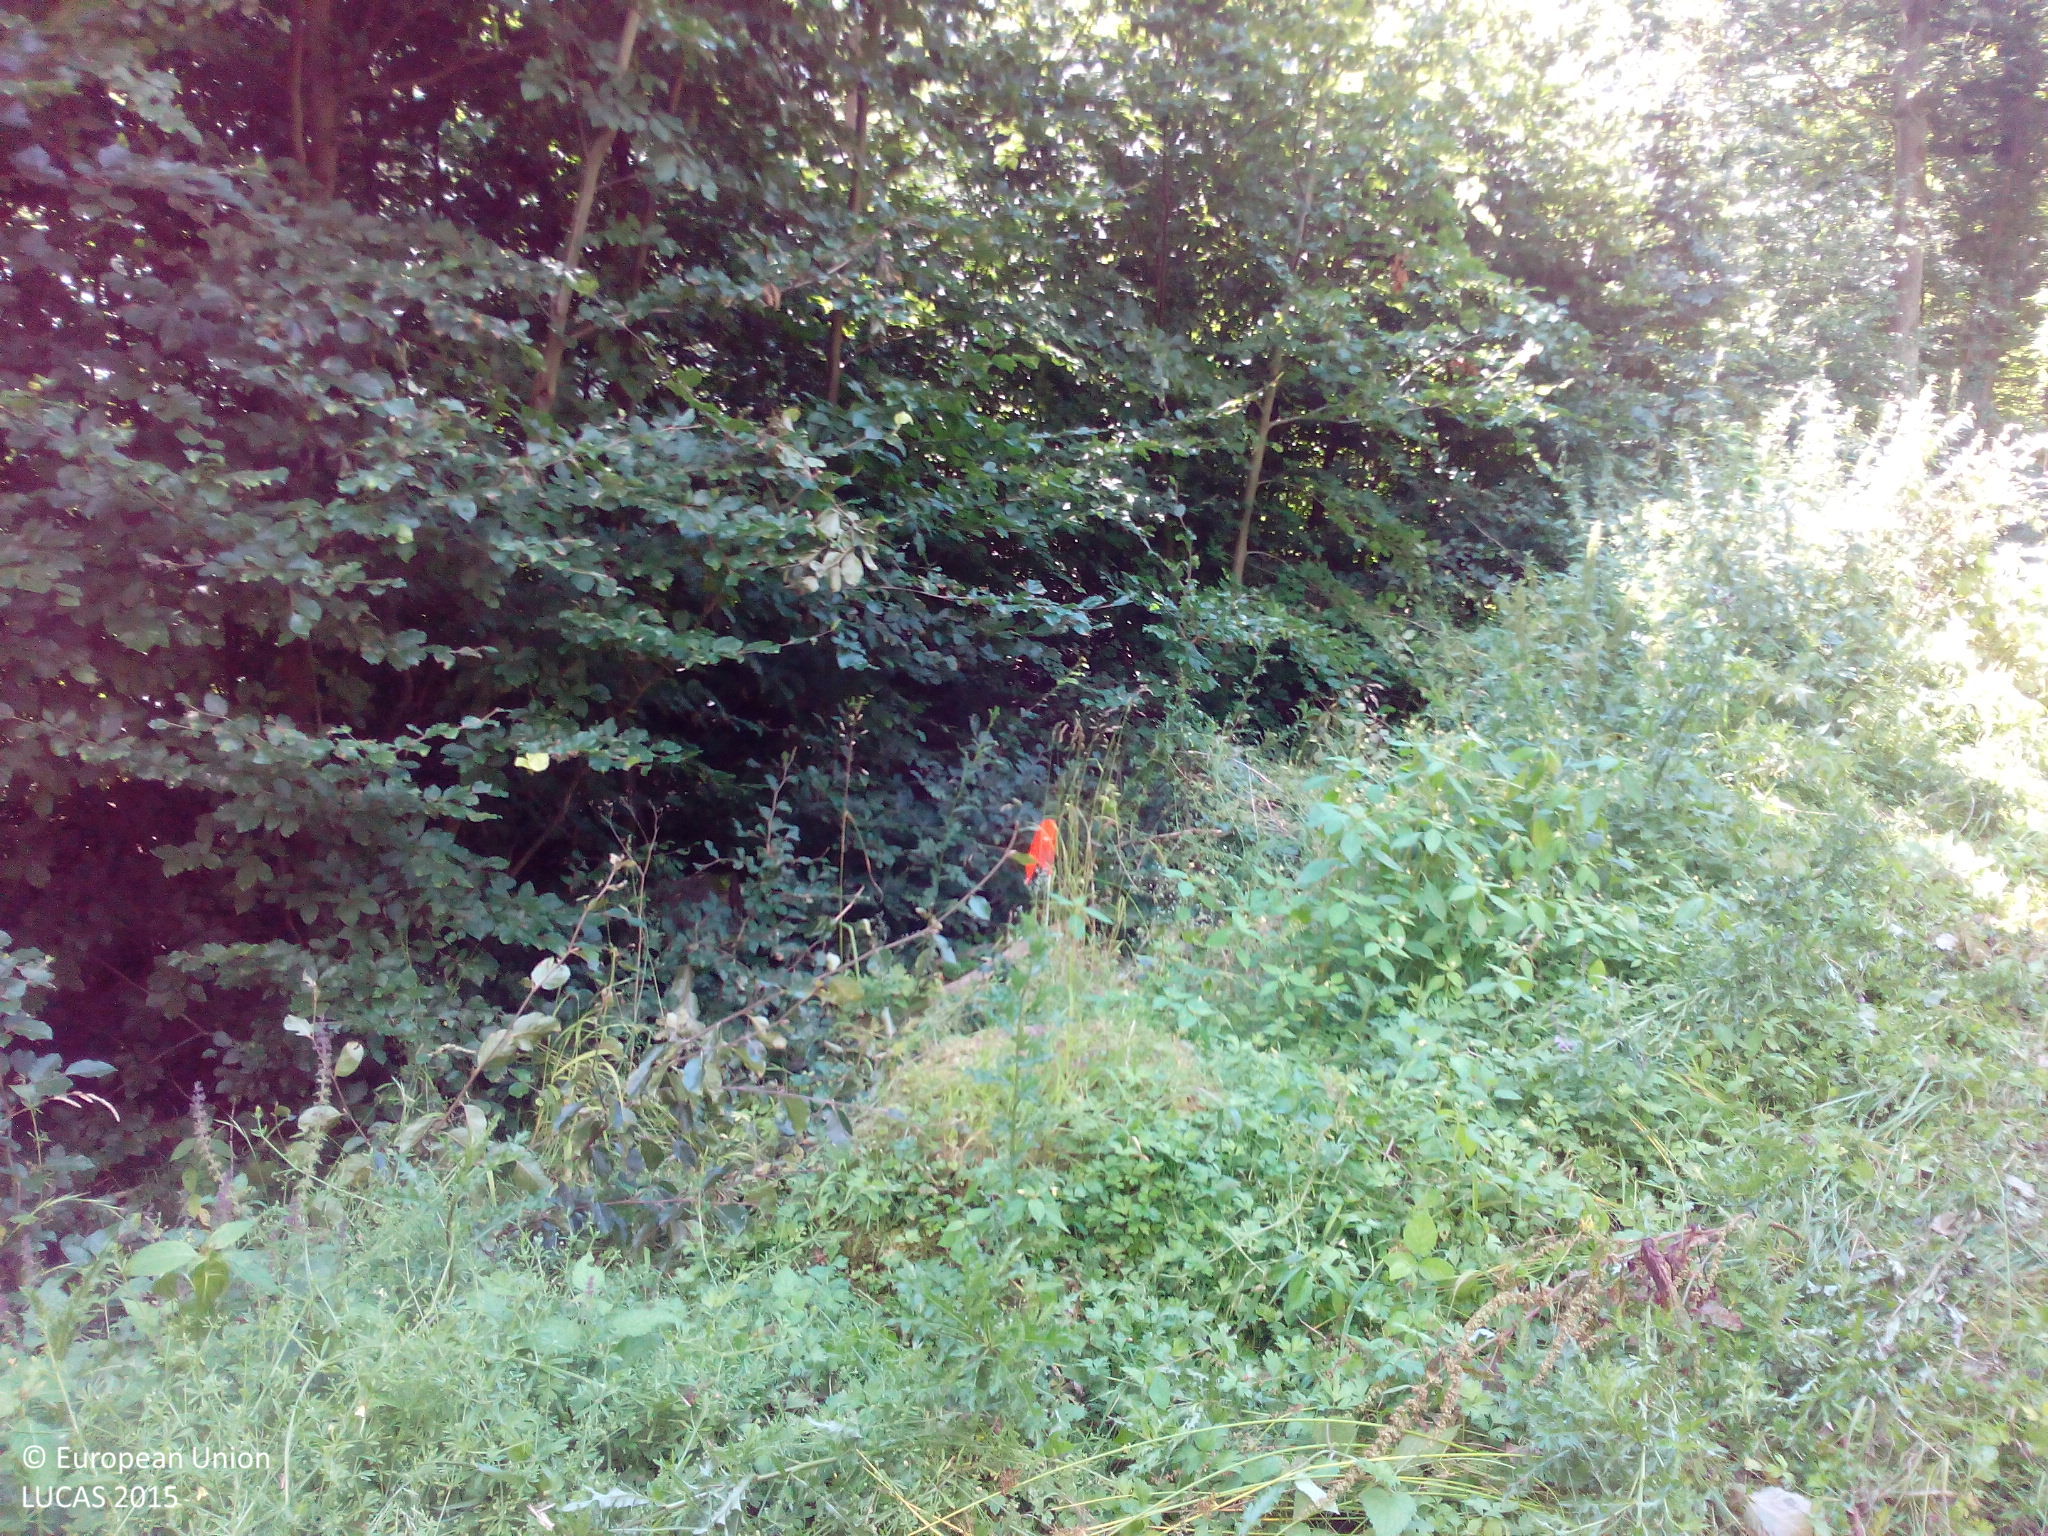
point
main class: Woodland
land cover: Broadleaved woodland
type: beech forest
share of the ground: 50 - 75 %
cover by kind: broadleaved forest trees 70 %, herbaceous plants 30 %
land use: Forestry
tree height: > 5 m
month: July
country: DE
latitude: 51.5129
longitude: 9.3518
